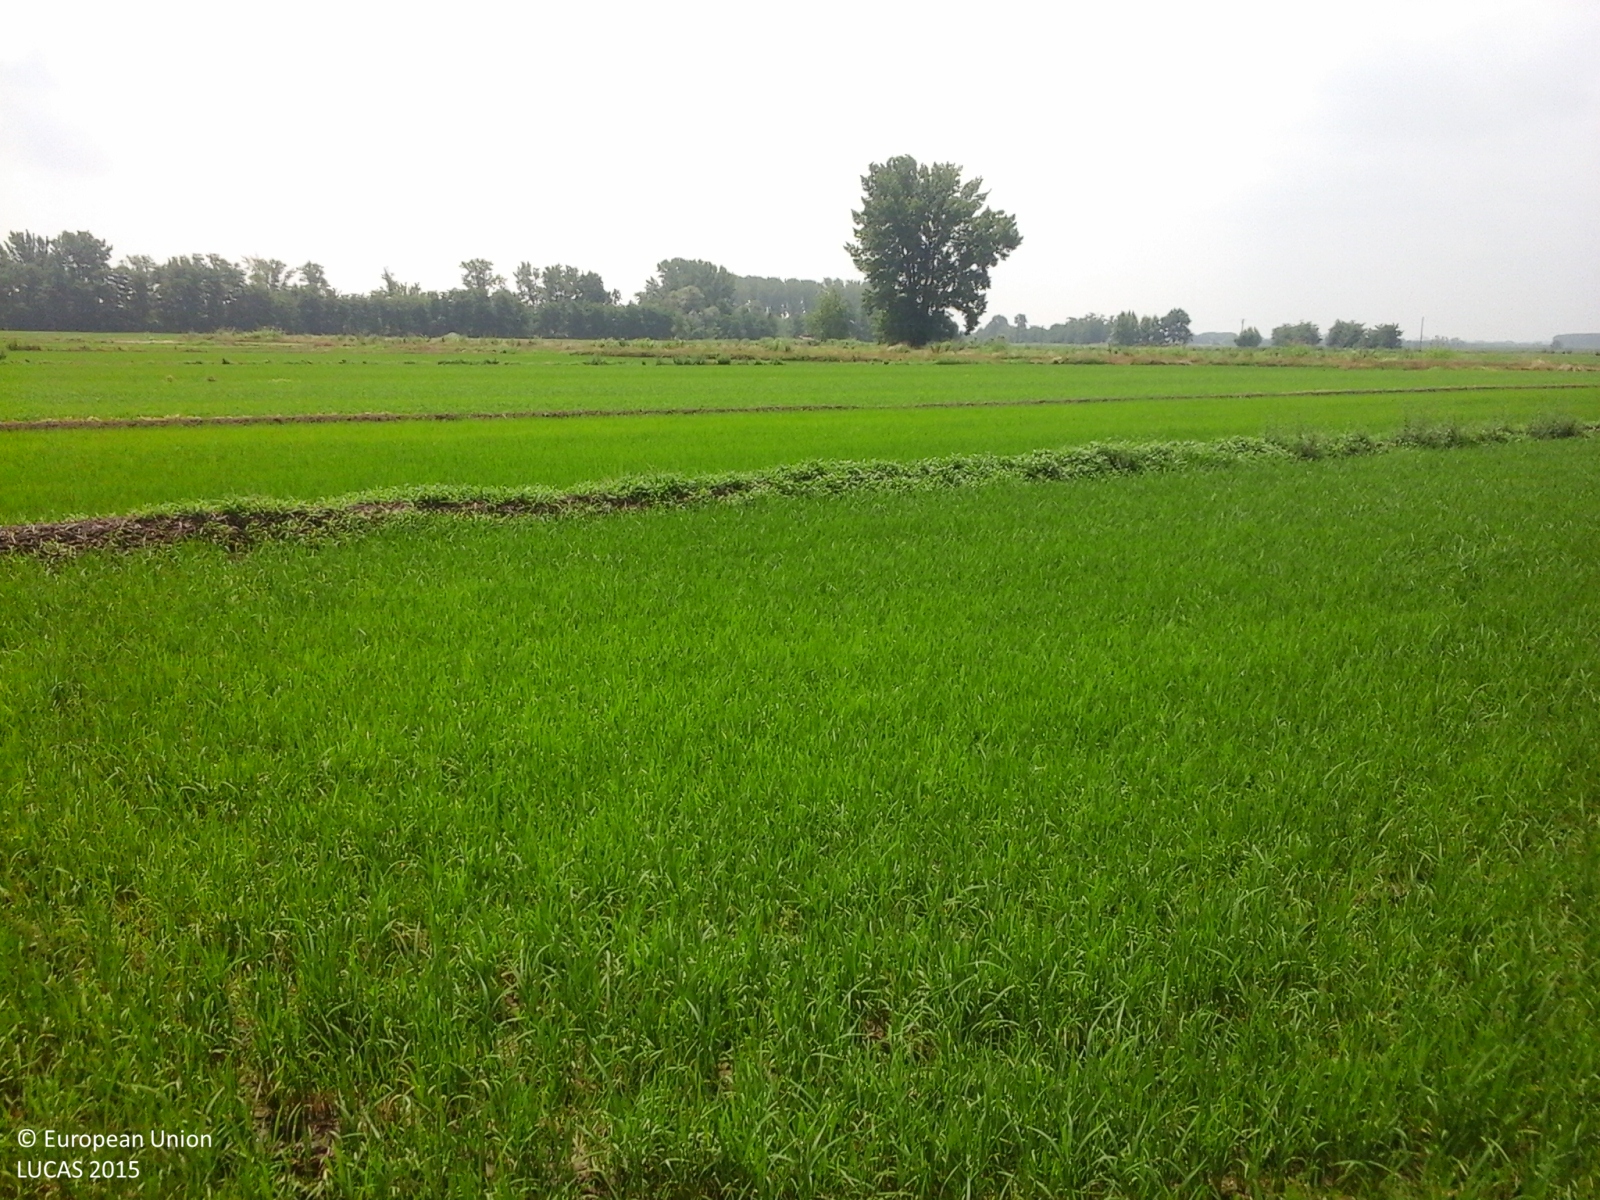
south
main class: Cropland
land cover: Rice
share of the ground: > 75 %
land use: Agriculture (excluding fallow land and kitchen gardens)
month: June
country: IT
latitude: 45.2426
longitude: 8.5884
